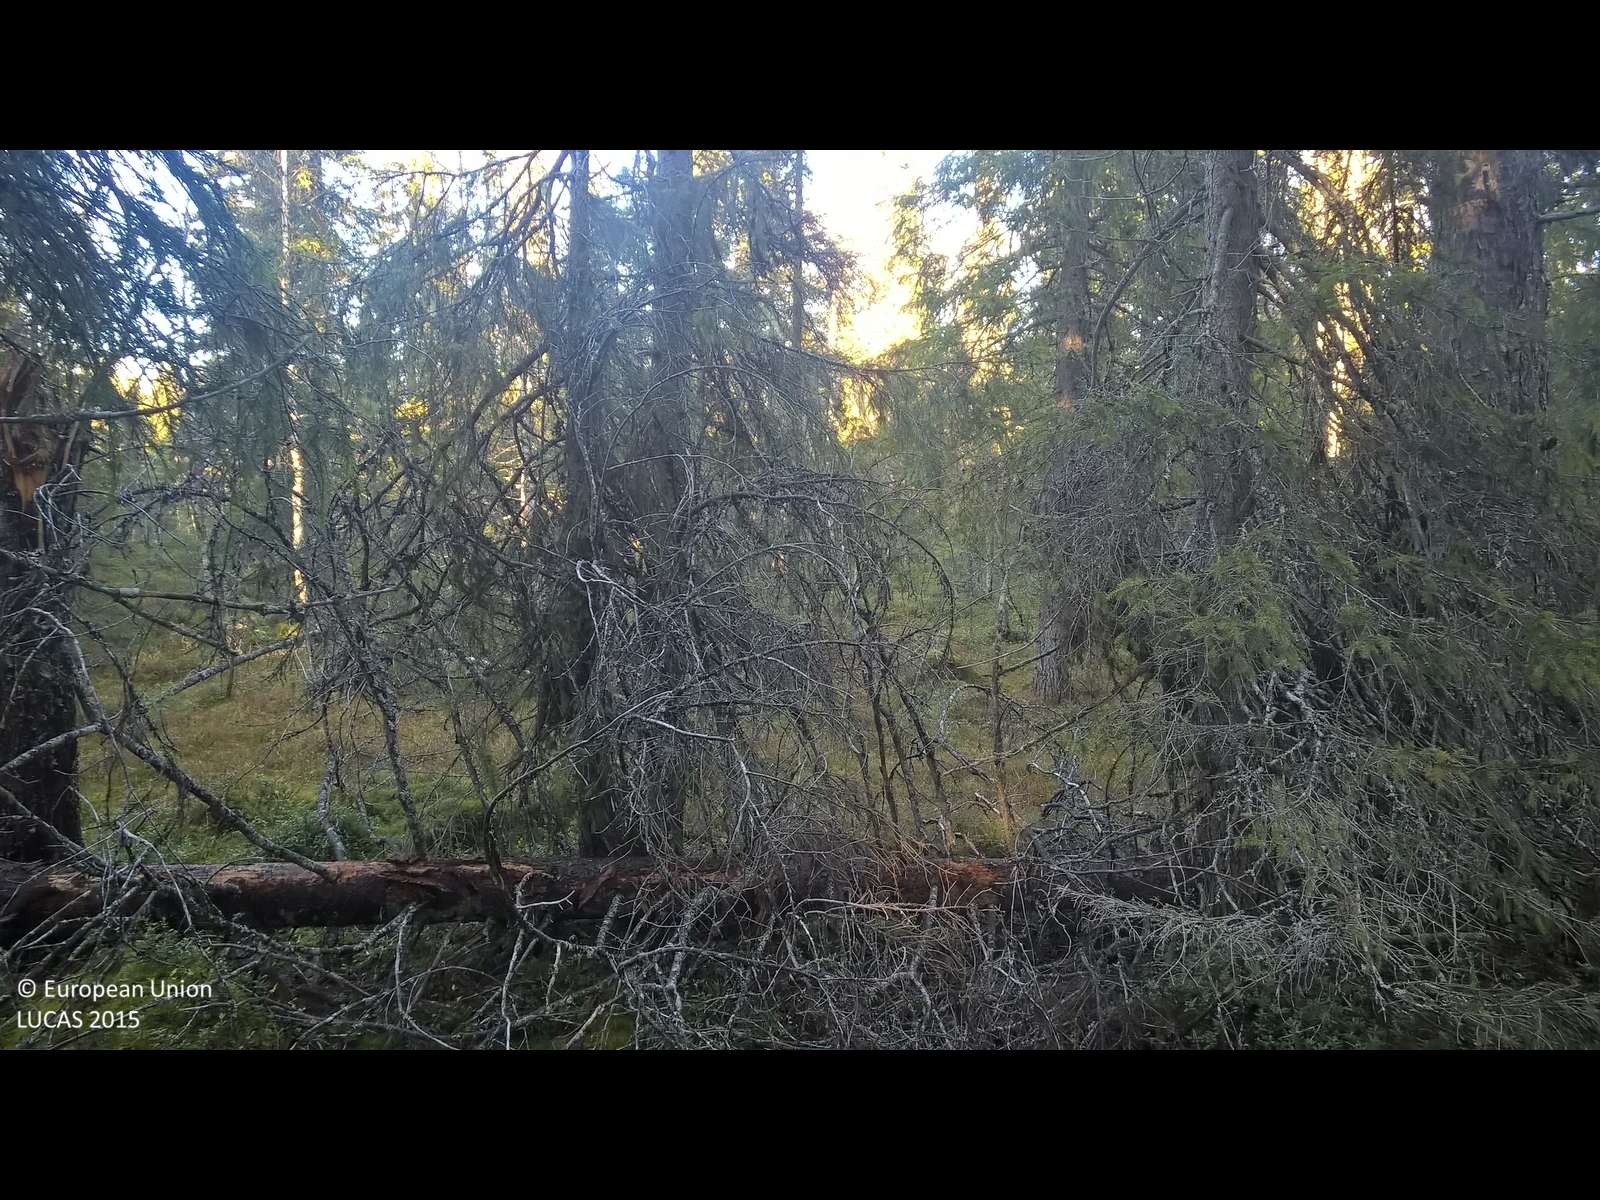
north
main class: Woodland
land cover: Spruce dominated coniferous woodland
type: boreal forest
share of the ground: > 75 %
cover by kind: coniferous forest trees 75 %, shrubs 20 %, herbaceous plants 5 %
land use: Forestry
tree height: > 5 m
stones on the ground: < 10 %
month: October
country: SE
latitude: 65.3684
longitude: 18.5410
